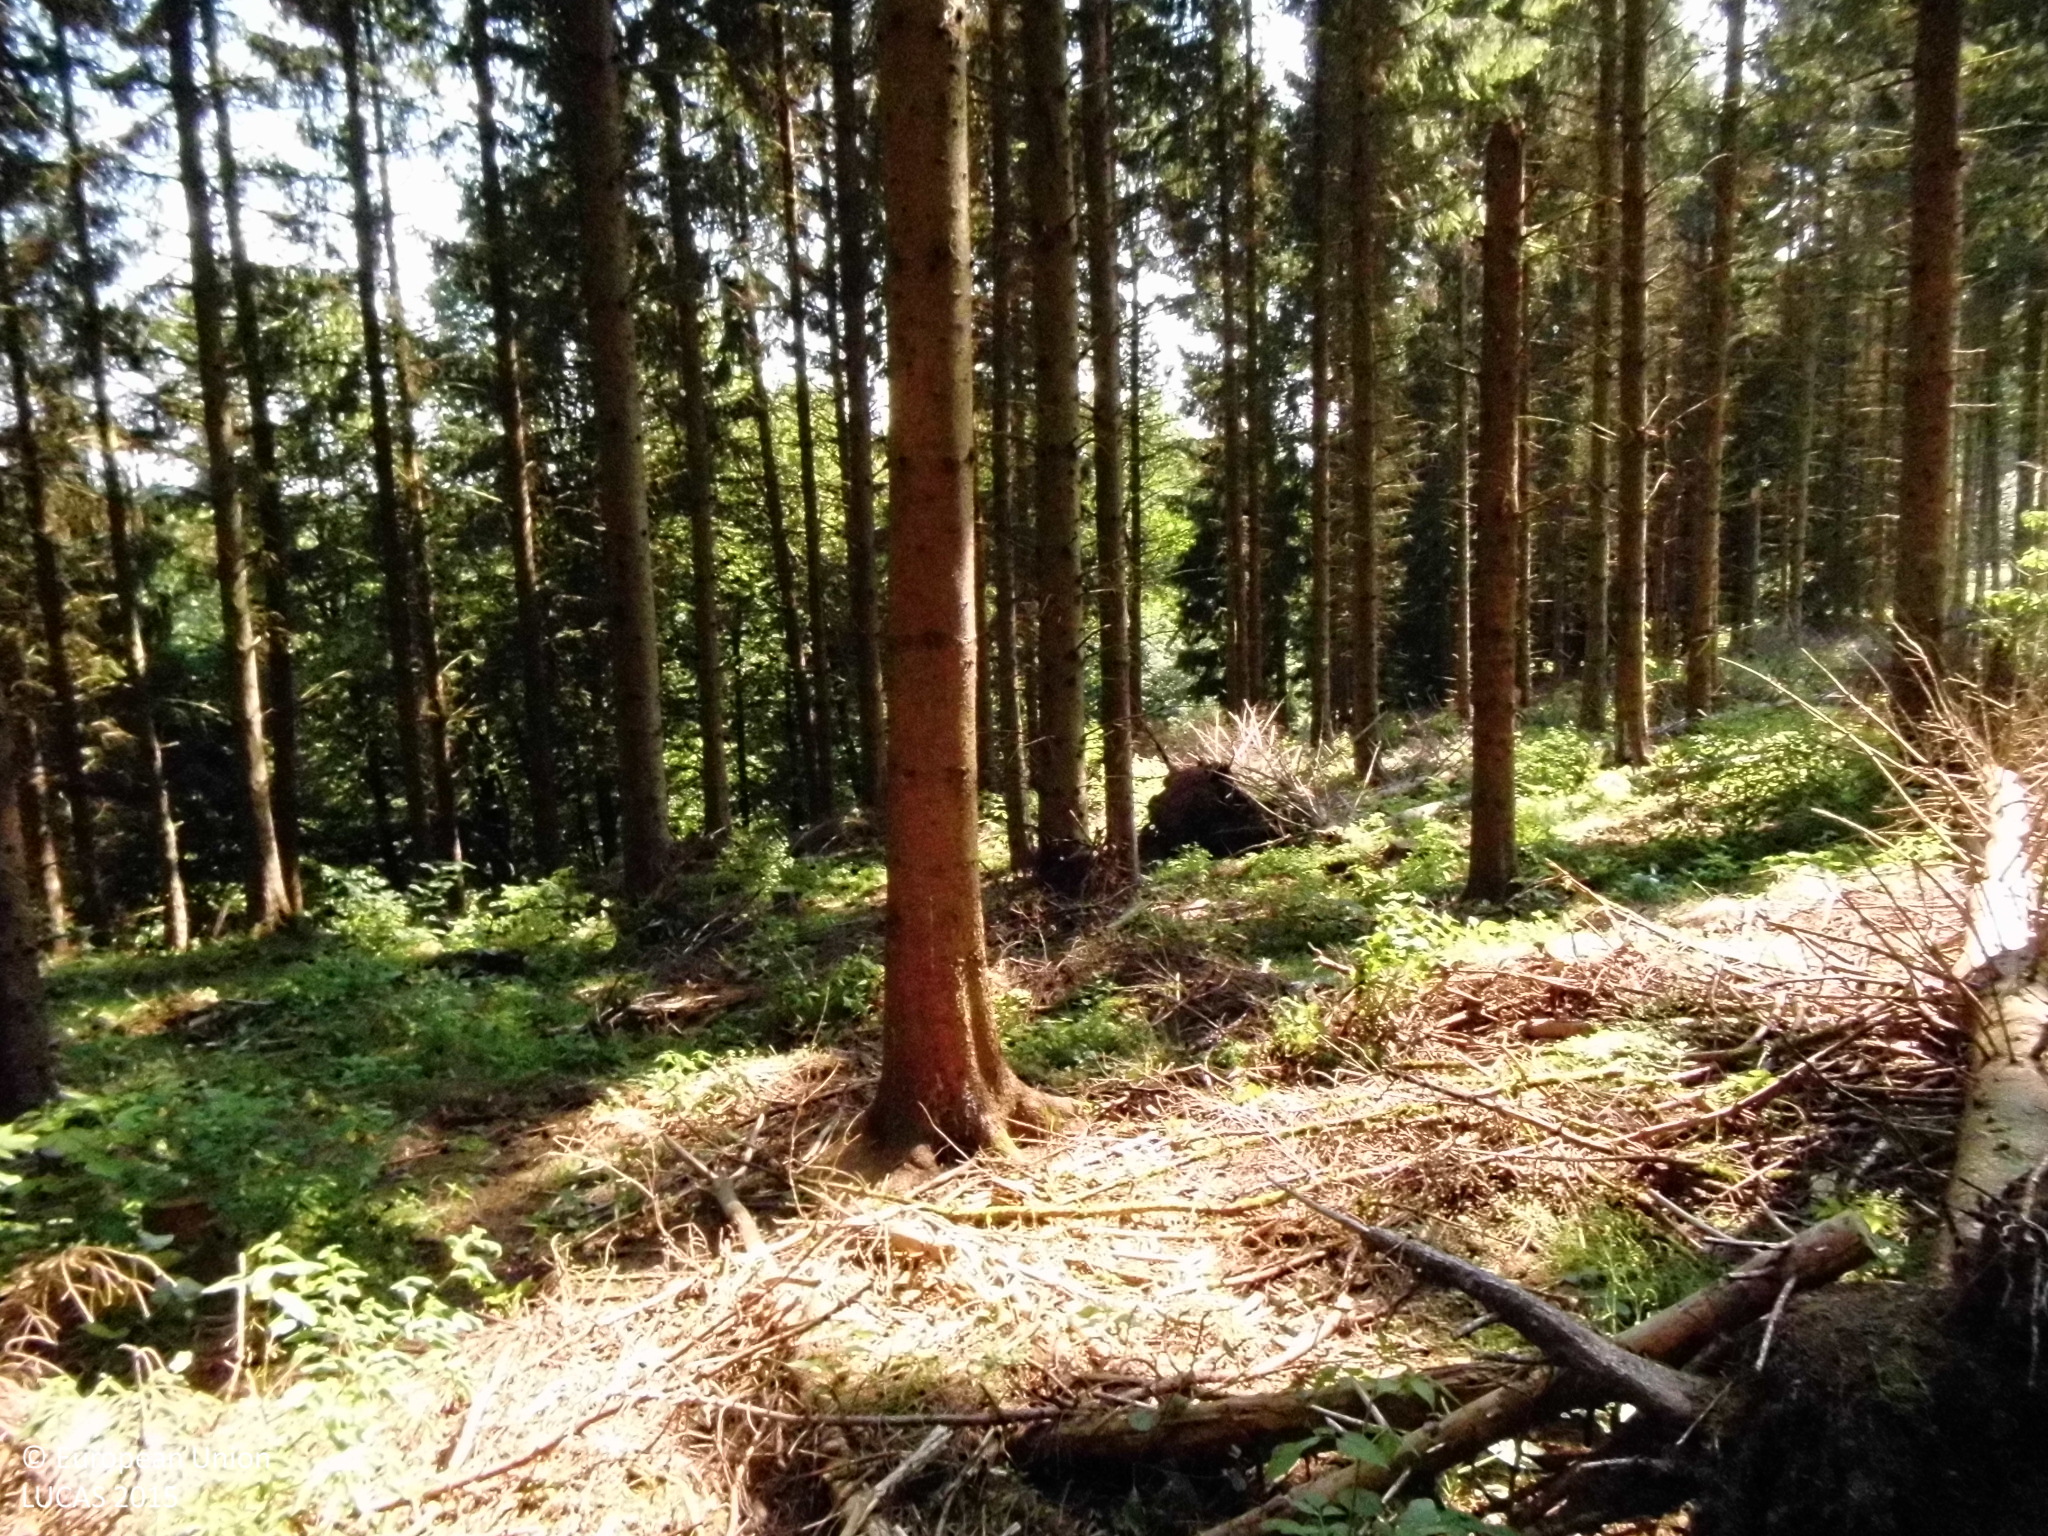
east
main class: Woodland
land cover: Spruce dominated coniferous woodland
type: hemiboreal forest and nemoral coniferous forest and mixed broadleaved-coniferous forest
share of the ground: > 75 %
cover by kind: coniferous forest trees 75 %, herbaceous plants 10 %, broadleaved forest trees 5 %, shrubs 5 %, unconsolidated bare surface 5 %
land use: Forestry
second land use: Amenities, museums, leisure
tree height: > 5 m
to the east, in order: Spruce dominated coniferous woodland; Shrubland without tree cover; Electric lines; Shrubland without tree cover; Broadleaved woodland; Shrubland without tree cover; Grassland without tree/shrub cover; Fences; Grassland without tree/shrub cover; Fences; Single bushes/trees; Grass margins; Paved roads, cycling and walking lanes; Grassland without tree/shrub cover
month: August
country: DE
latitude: 50.5626
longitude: 8.0099
